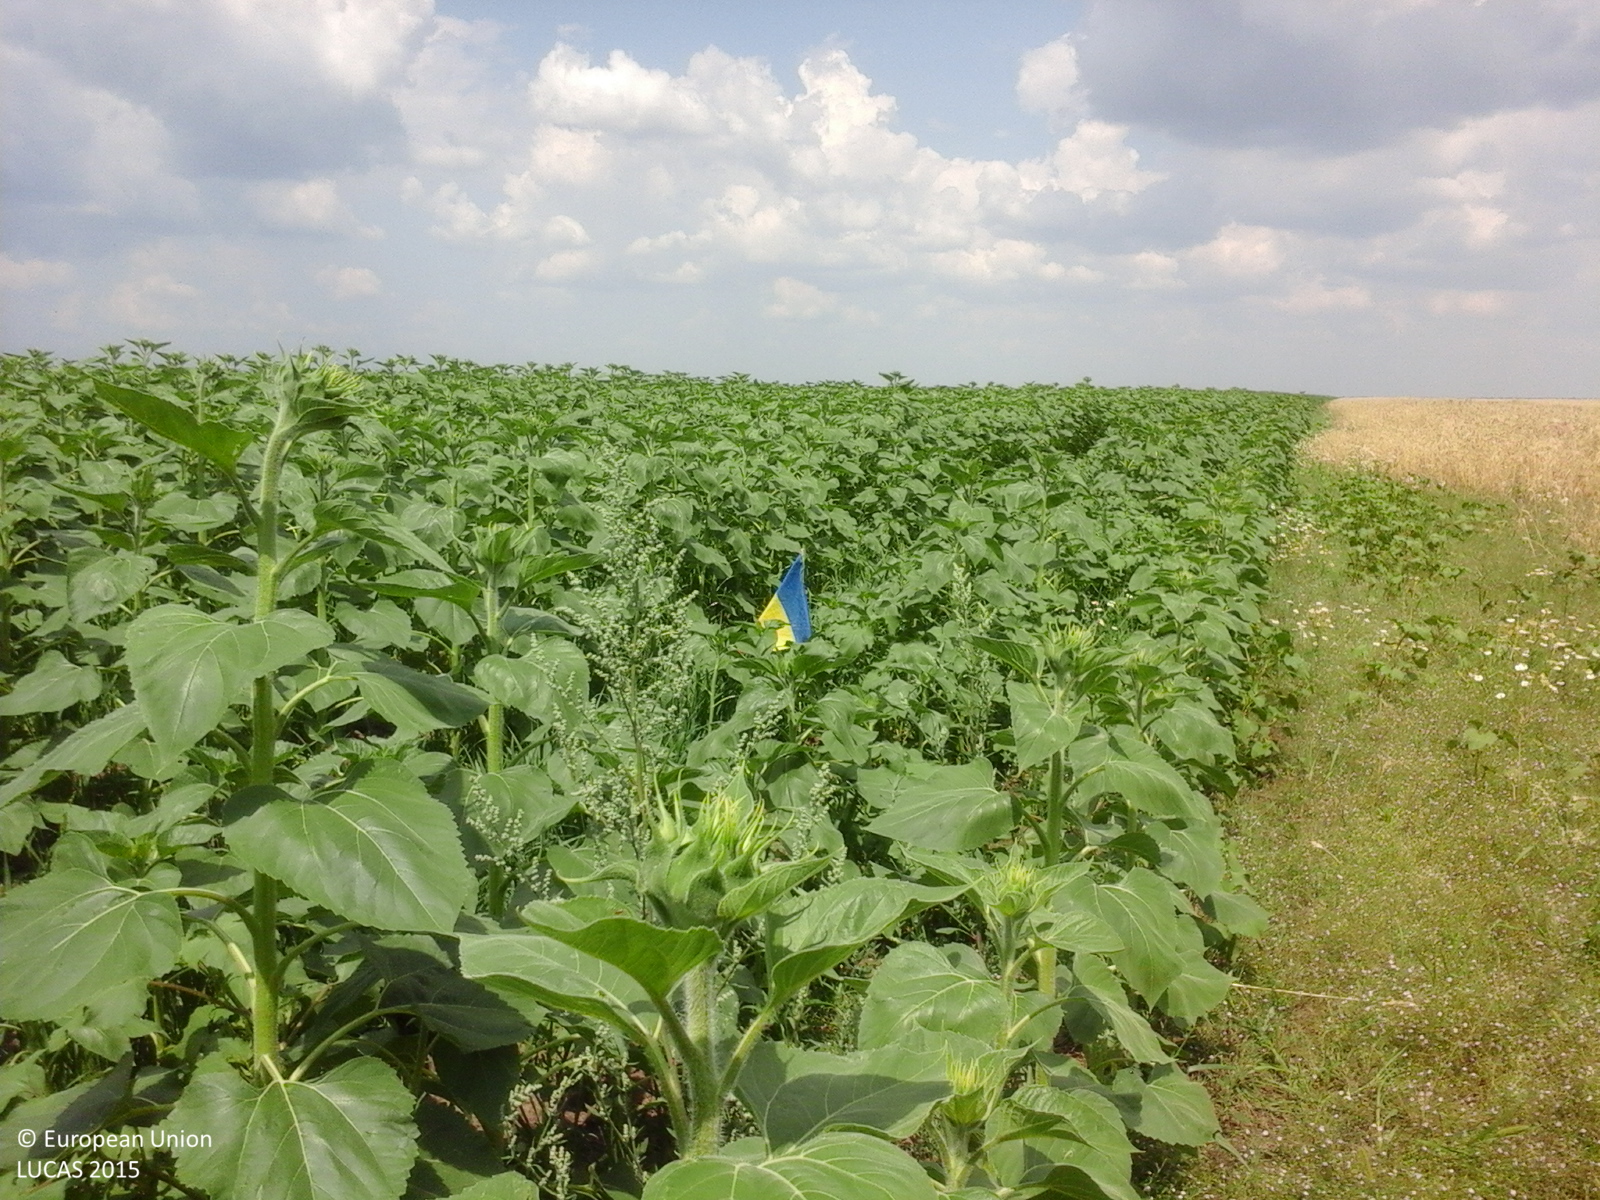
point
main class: Cropland
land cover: Sunflower
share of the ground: > 75 %
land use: Agriculture (excluding fallow land and kitchen gardens)
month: July
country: RO
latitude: 44.0551
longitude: 25.2736
